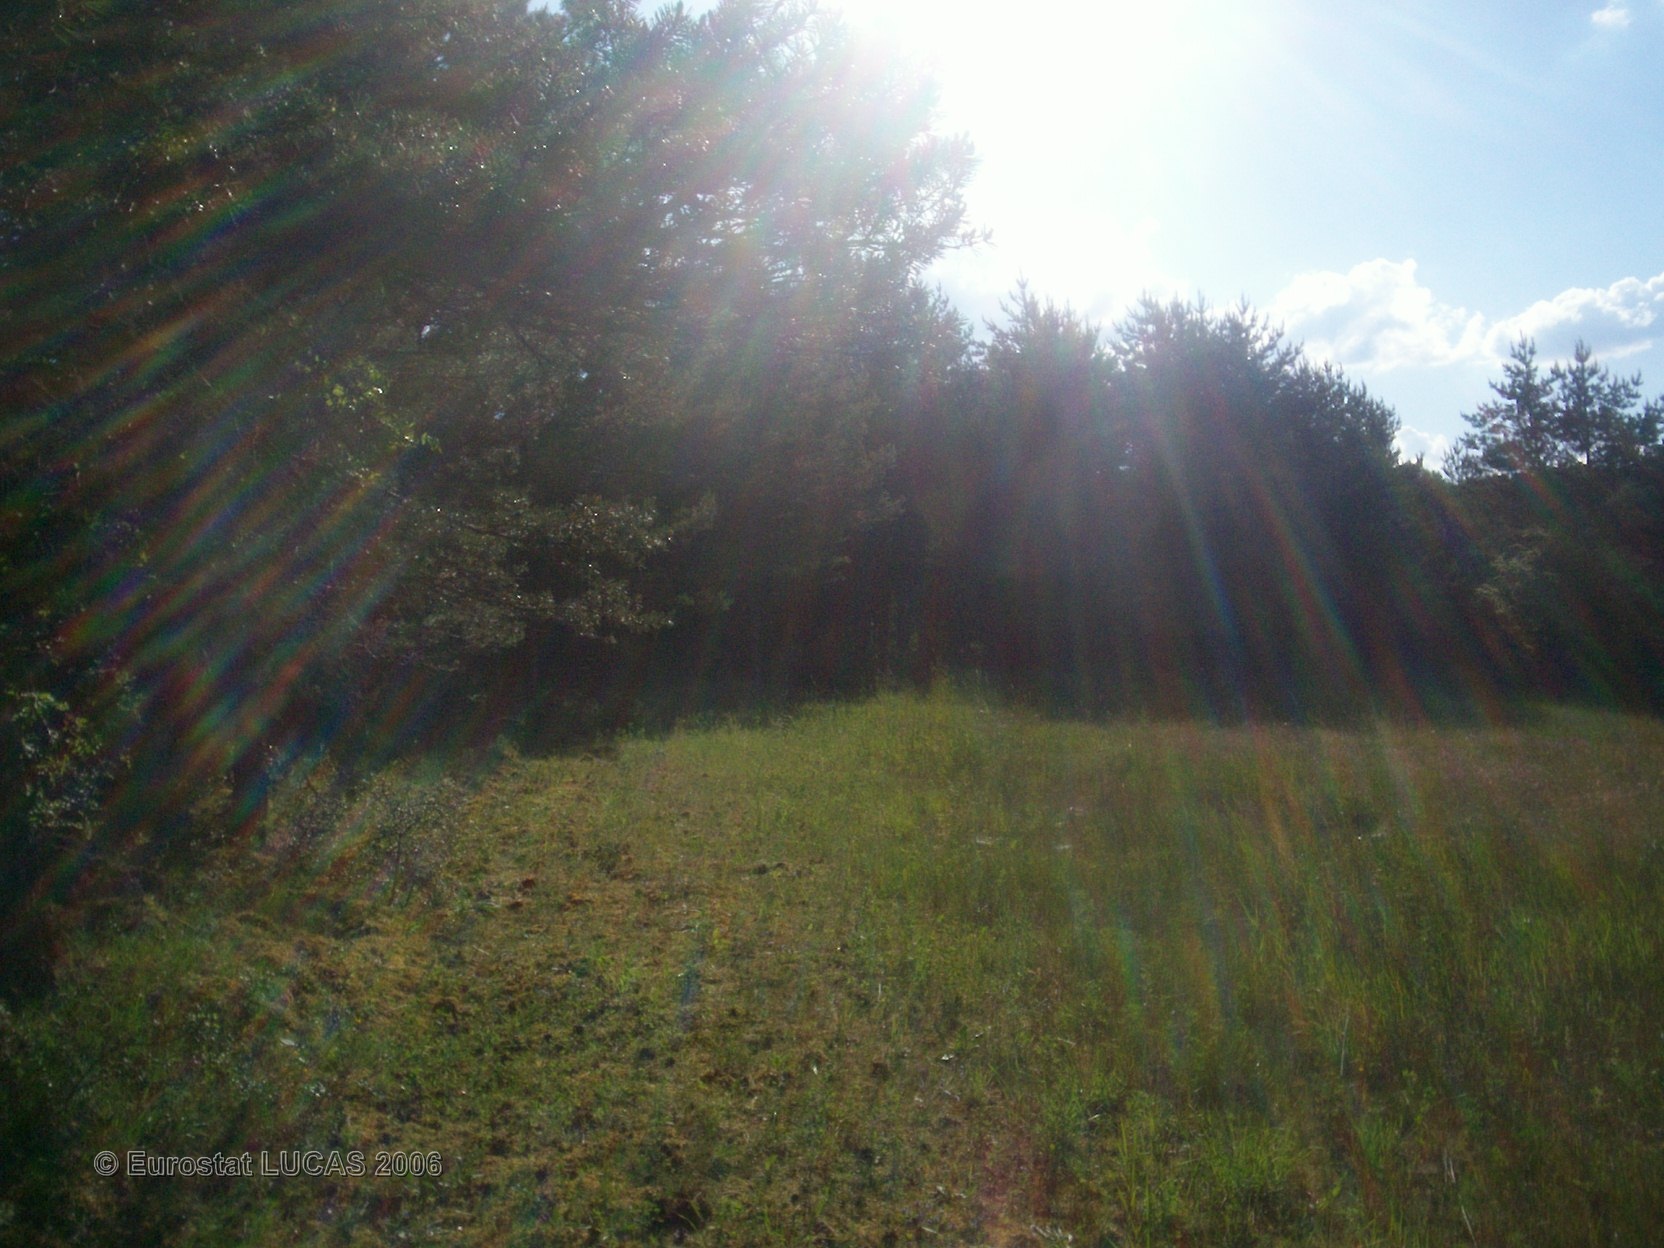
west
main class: Grassland
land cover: Grassland without tree/shrub cover
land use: Agriculture (excluding fallow land and kitchen gardens)
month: June
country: FR
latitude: 44.2868
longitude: 3.4269
